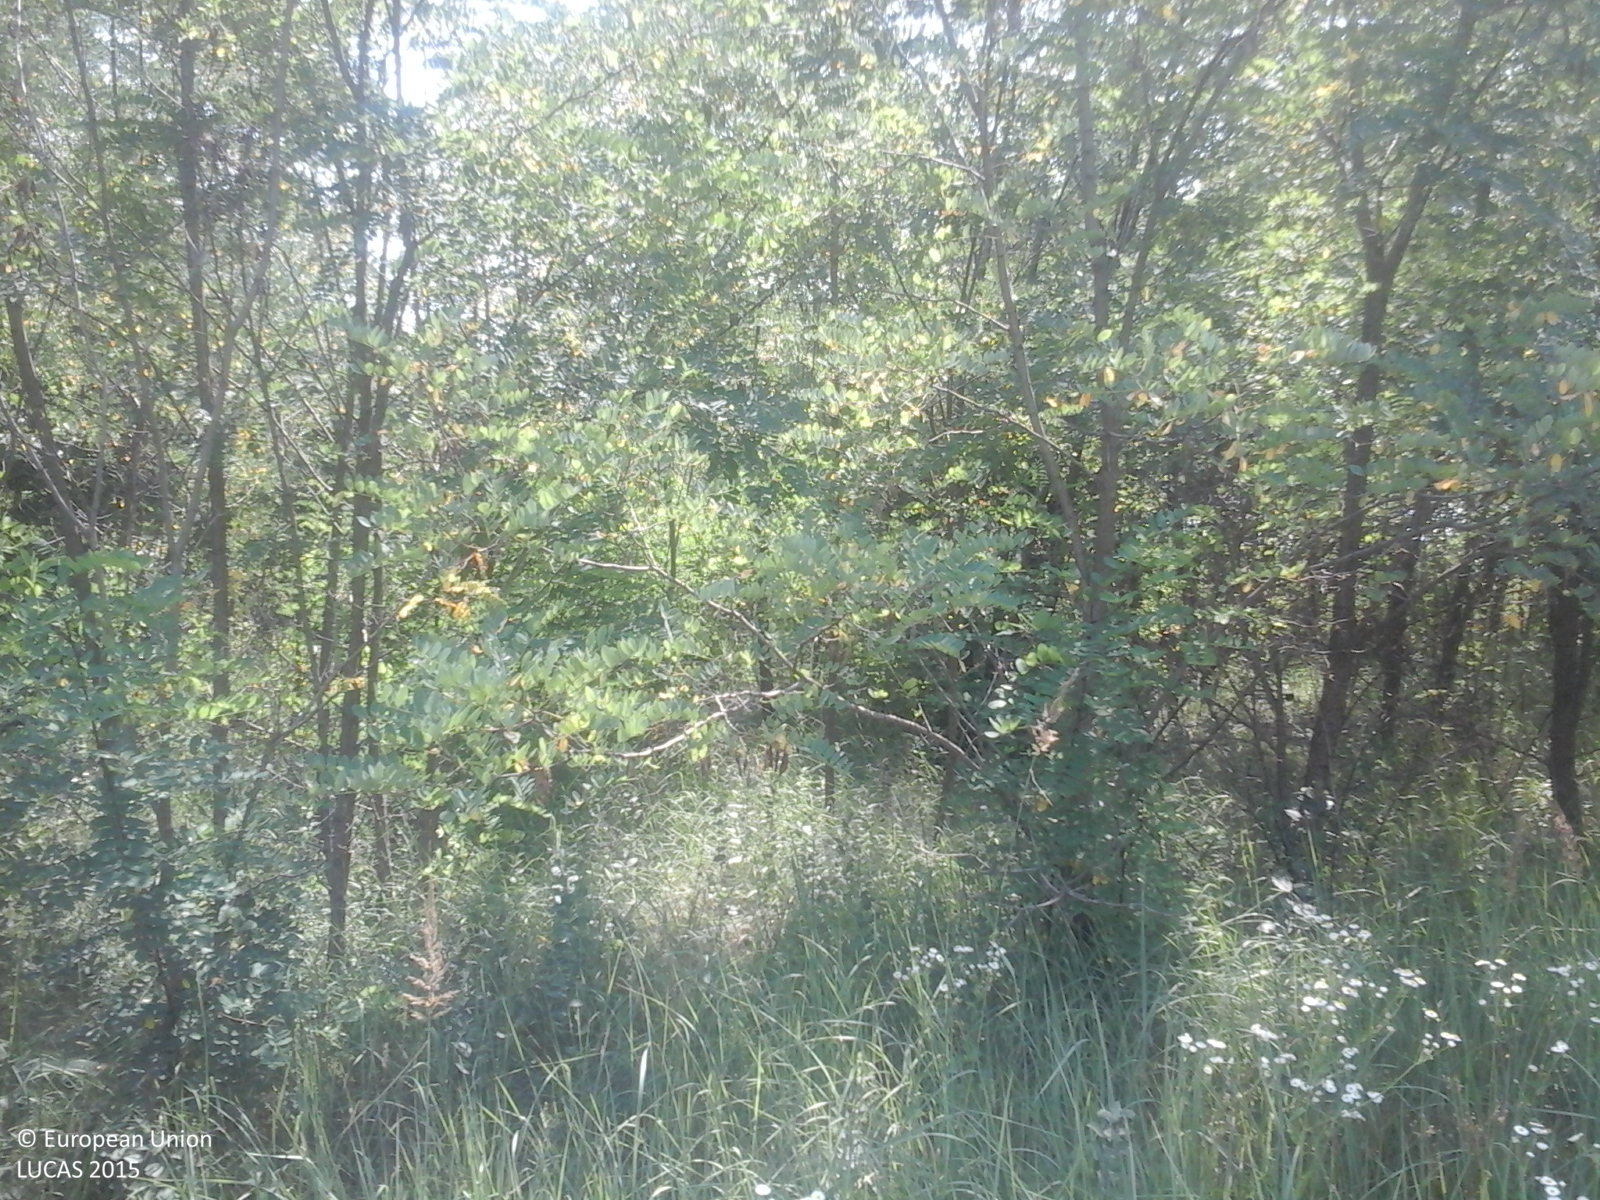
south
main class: Woodland
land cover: Broadleaved woodland
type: broadleaved evergreen forest
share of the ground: > 75 %
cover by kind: broadleaved forest trees 80 %, herbaceous plants 20 %
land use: Forestry
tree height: < 5 m
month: July
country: RO
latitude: 44.7490
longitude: 25.4135
